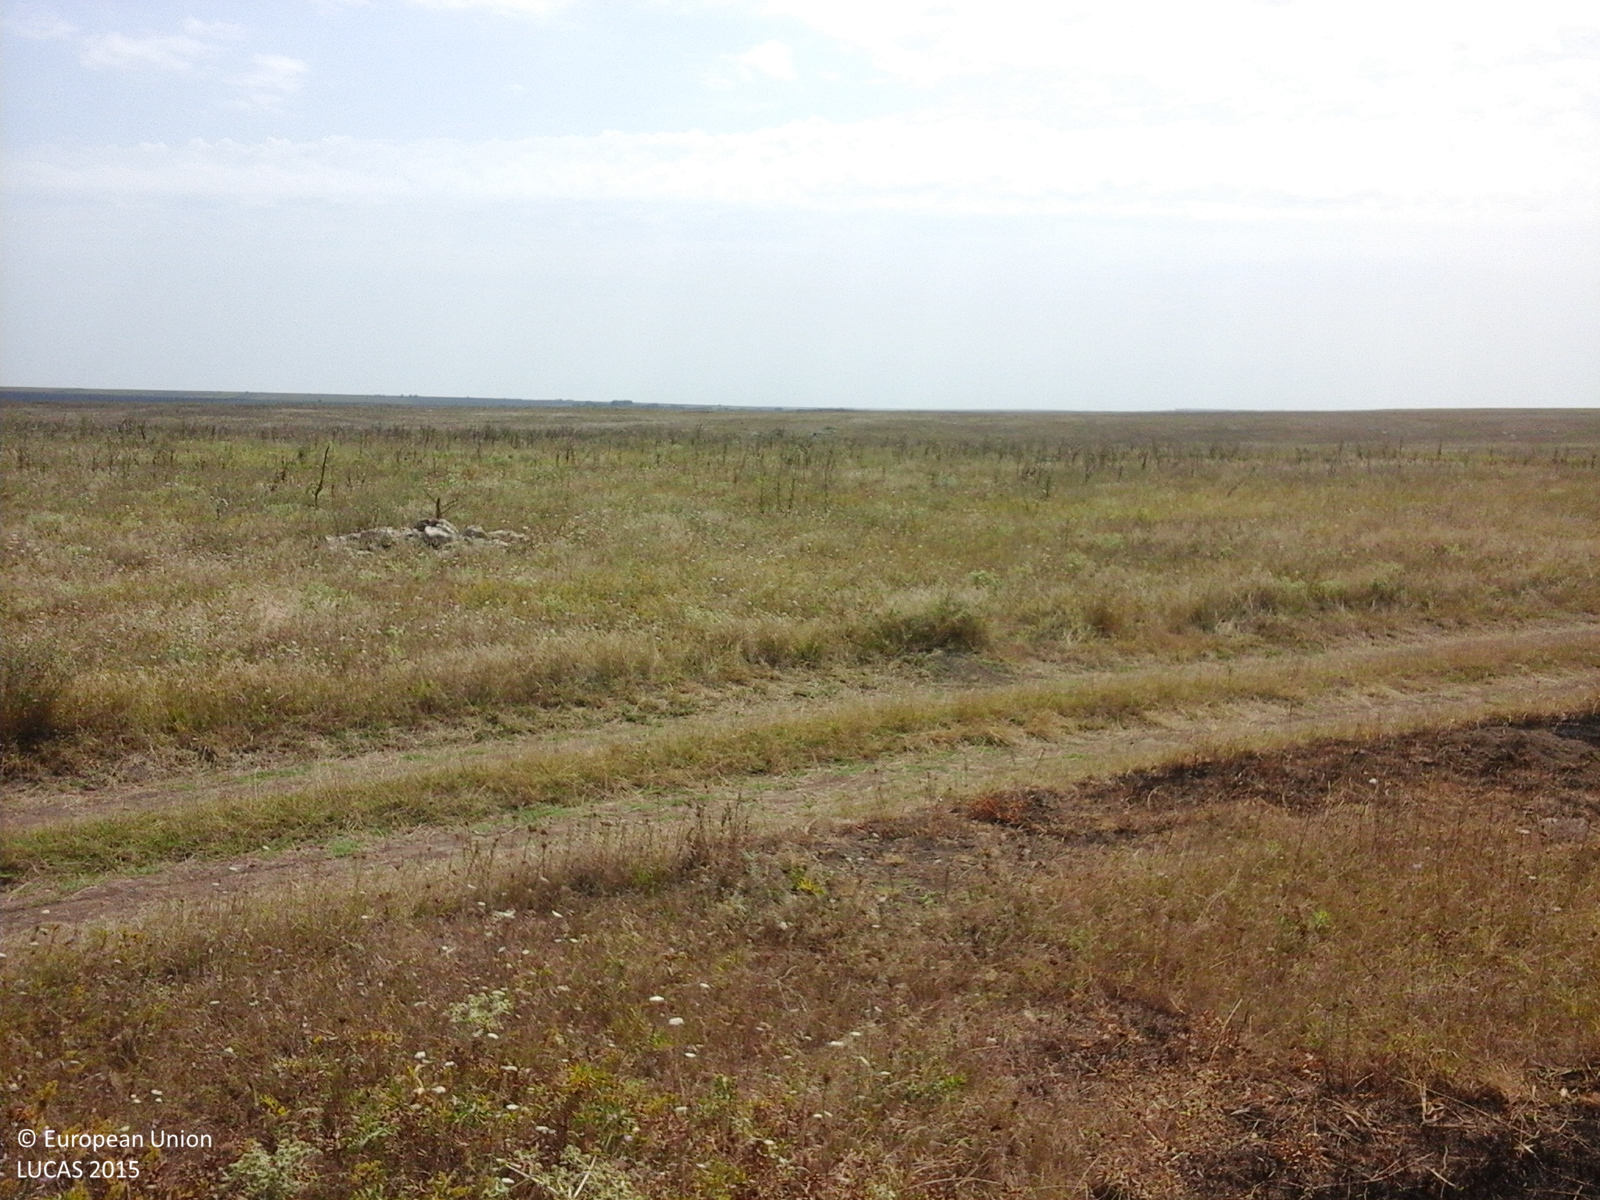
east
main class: Grassland
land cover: Spontaneously vegetated surfaces
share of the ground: > 75 %
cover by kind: herbaceous plants 70 %, consolidated bare surface 30 %
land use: Fallow land
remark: Burnt area
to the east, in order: Spontaneously vegetated surfaces; Tracks; Spontaneously vegetated surfaces
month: August
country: RO
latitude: 43.7660
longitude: 28.3585
